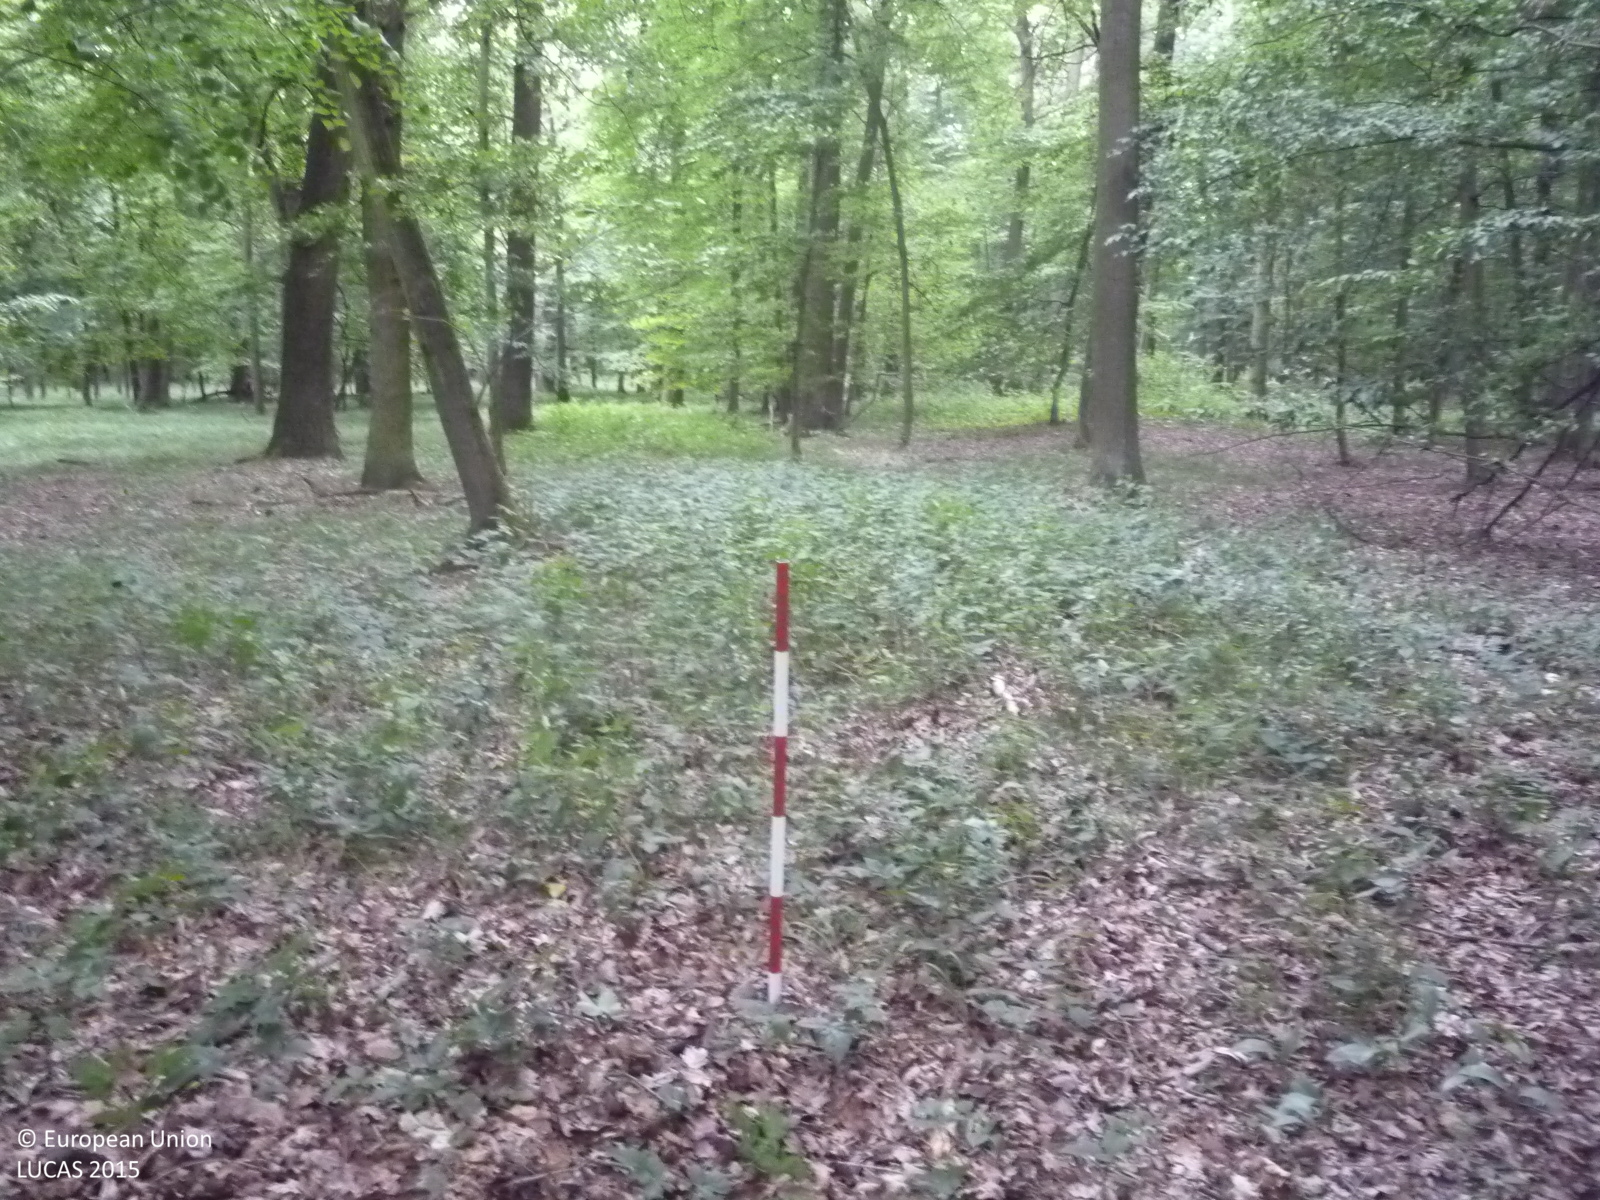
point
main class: Woodland
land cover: Broadleaved woodland
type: mesophytic deciduous forest
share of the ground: > 75 %
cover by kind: broadleaved forest trees 90 %, unconsolidated bare surface 10 %
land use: Forestry
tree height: > 5 m
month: July
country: CZ
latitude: 50.2781
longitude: 15.6597
